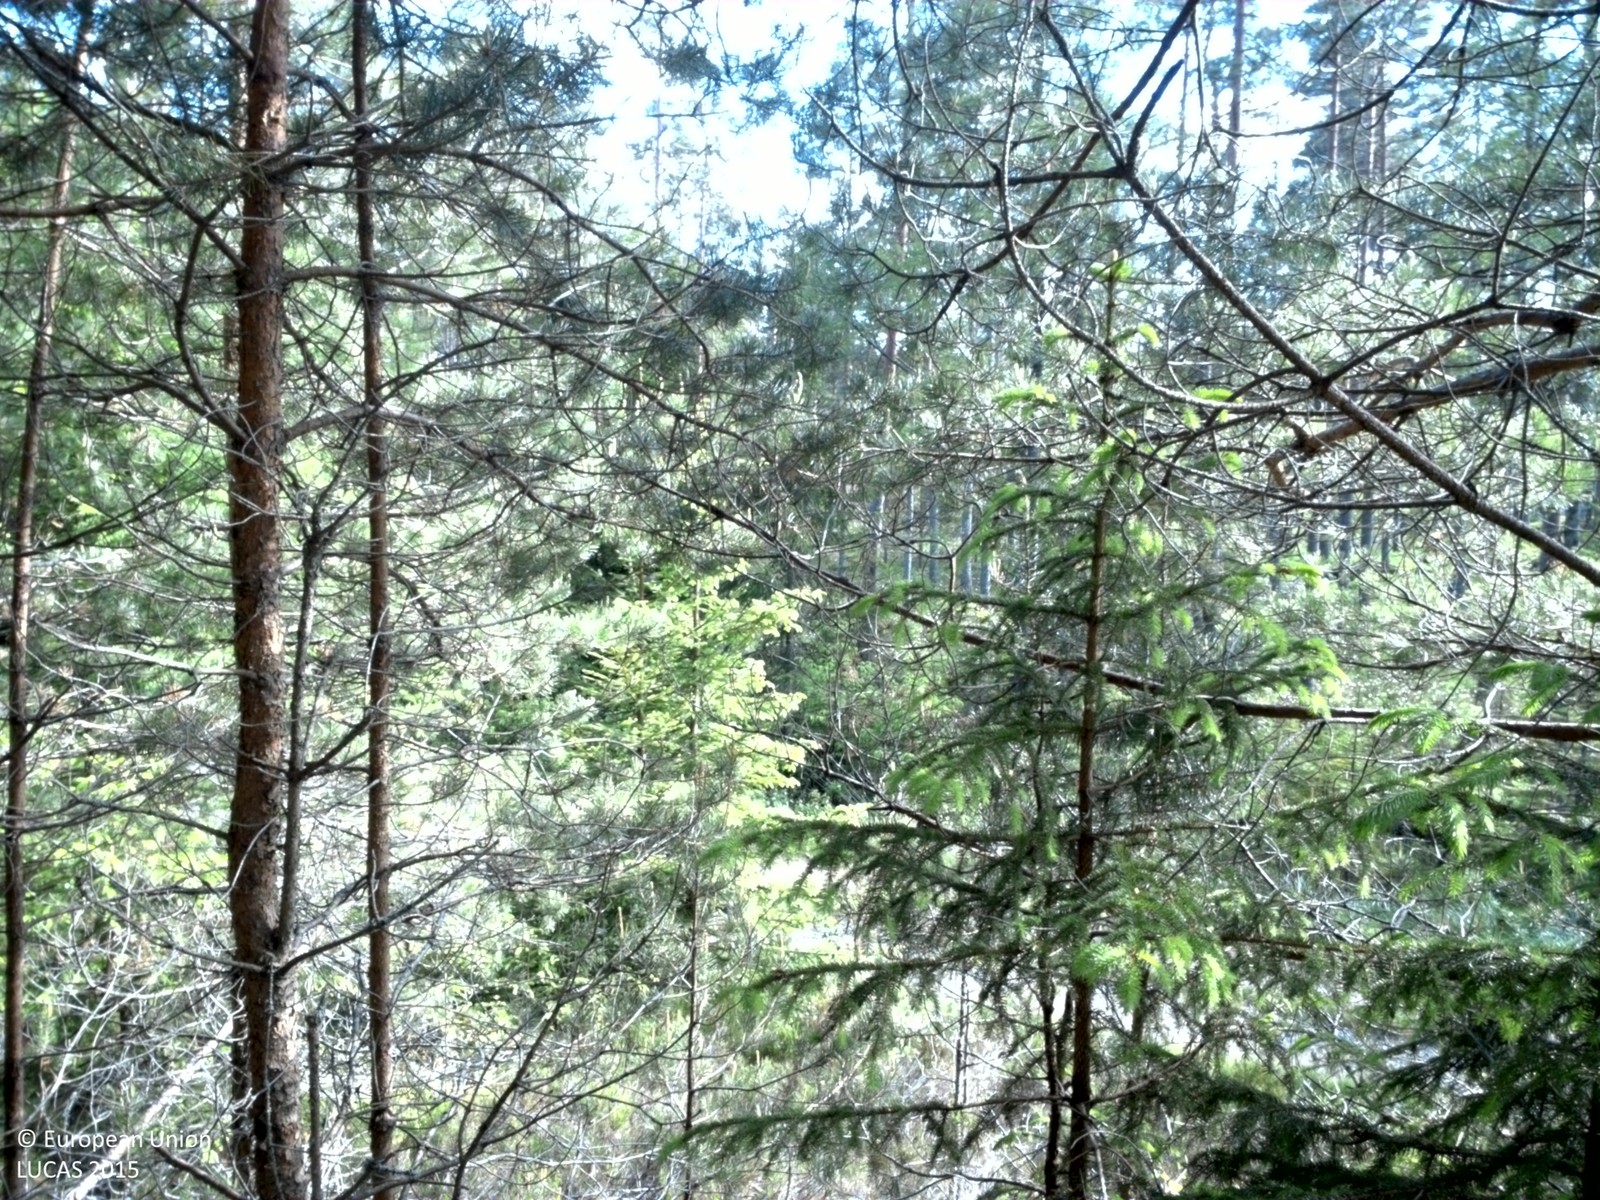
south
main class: Woodland
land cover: Other coniferous woodland
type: boreal forest
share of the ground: > 75 %
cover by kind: coniferous forest trees 80 %, broadleaved forest trees 5 %, shrubs 5 %, herbaceous plants 5 %, lichens and mosses 5 %
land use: Forestry
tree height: > 5 m
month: June
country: SE
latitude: 58.7330
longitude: 14.6742
